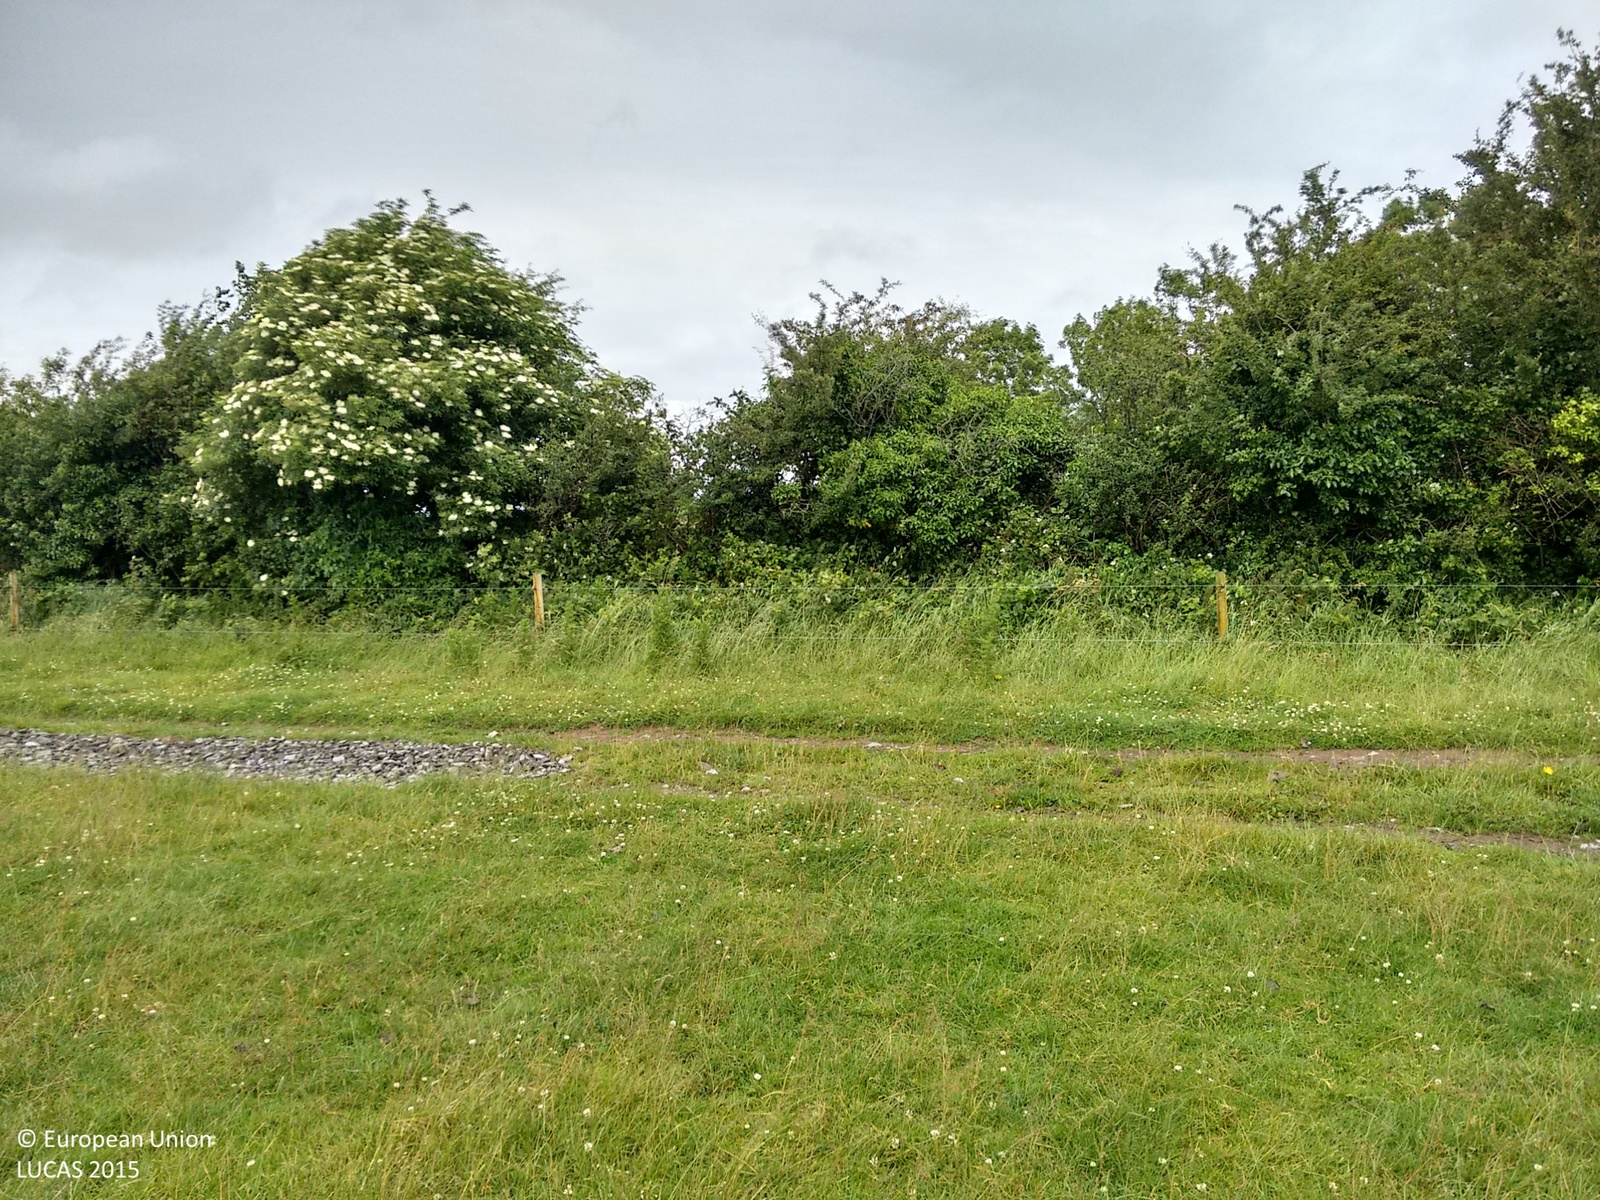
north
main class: Grassland
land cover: Grassland without tree/shrub cover
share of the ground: > 75 %
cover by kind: herbaceous plants 100 %
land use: Agriculture (excluding fallow land and kitchen gardens)
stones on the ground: < 10 %
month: July
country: IE
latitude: 53.6536
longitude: -8.0453
